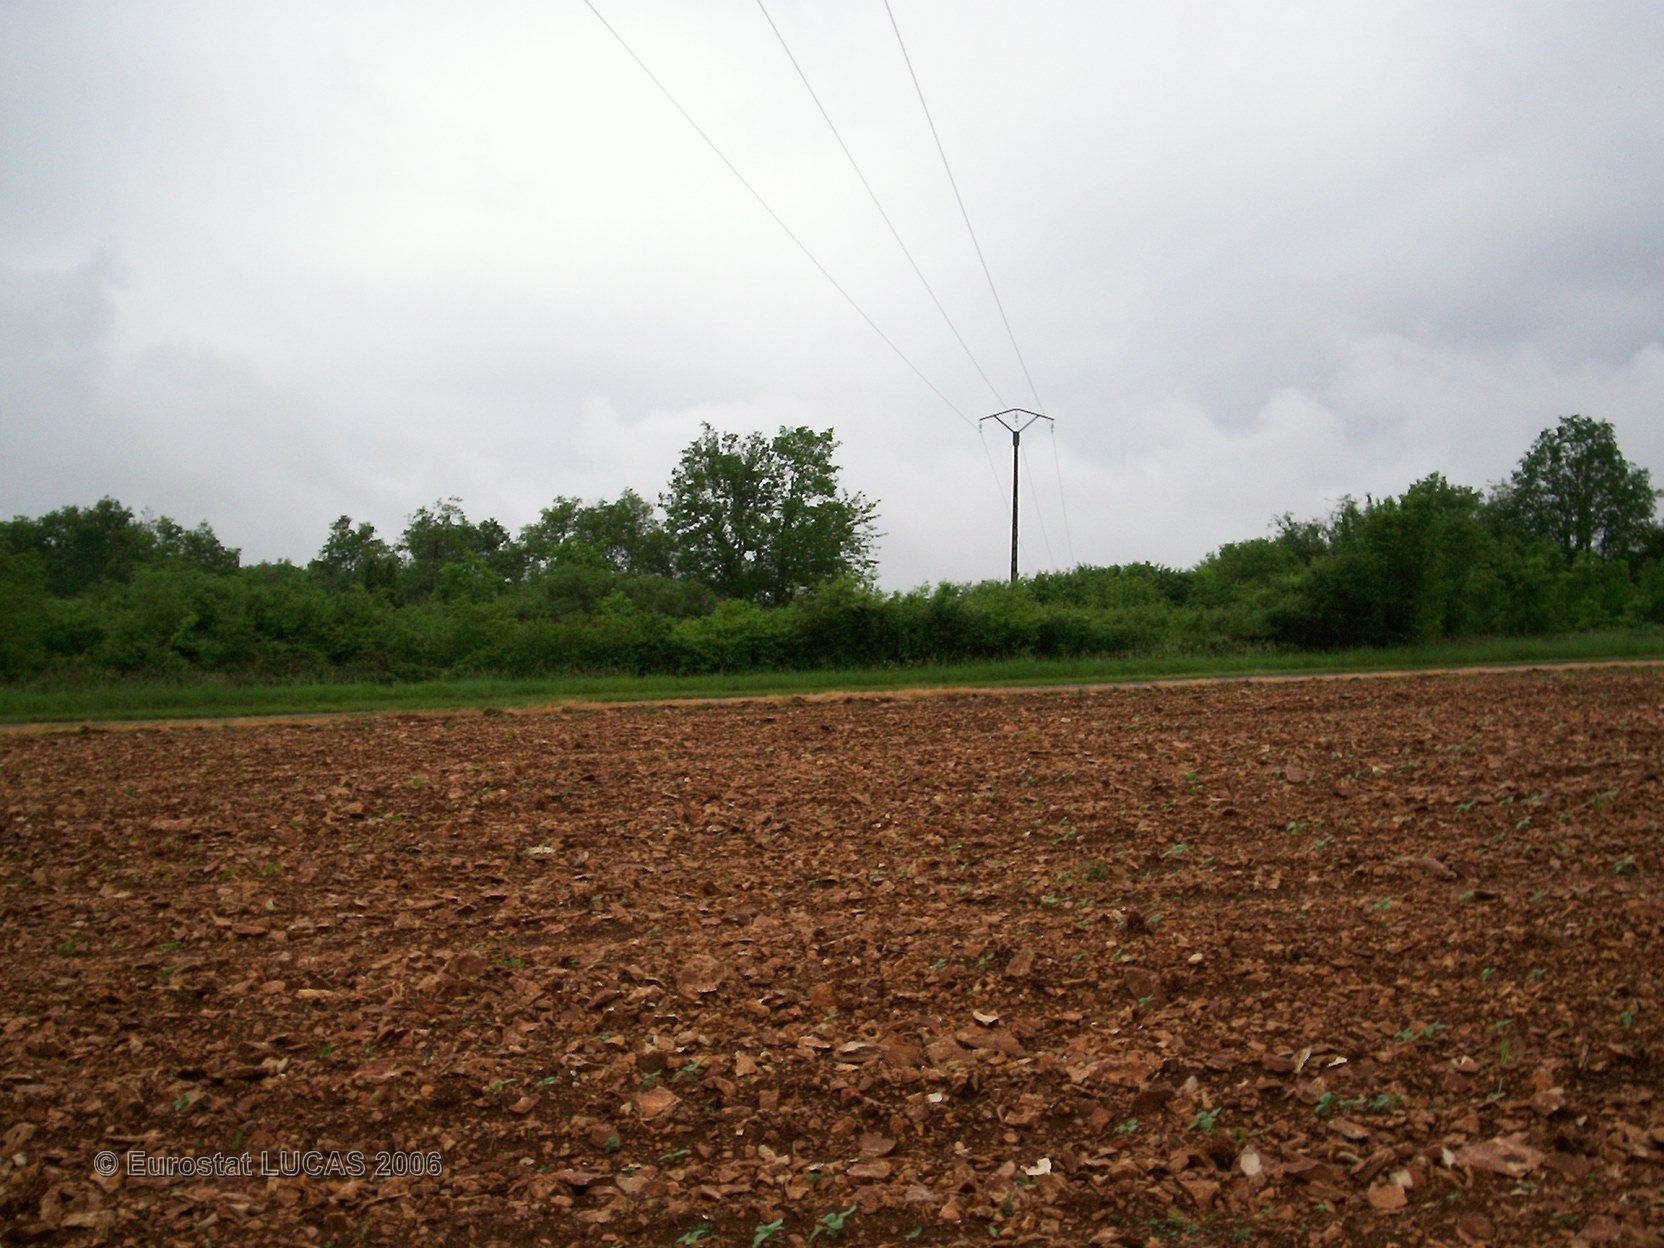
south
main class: Cropland
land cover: Sunflower
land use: Agriculture (excluding fallow land and kitchen gardens)
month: May
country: FR
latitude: 45.6558
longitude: 0.5027
